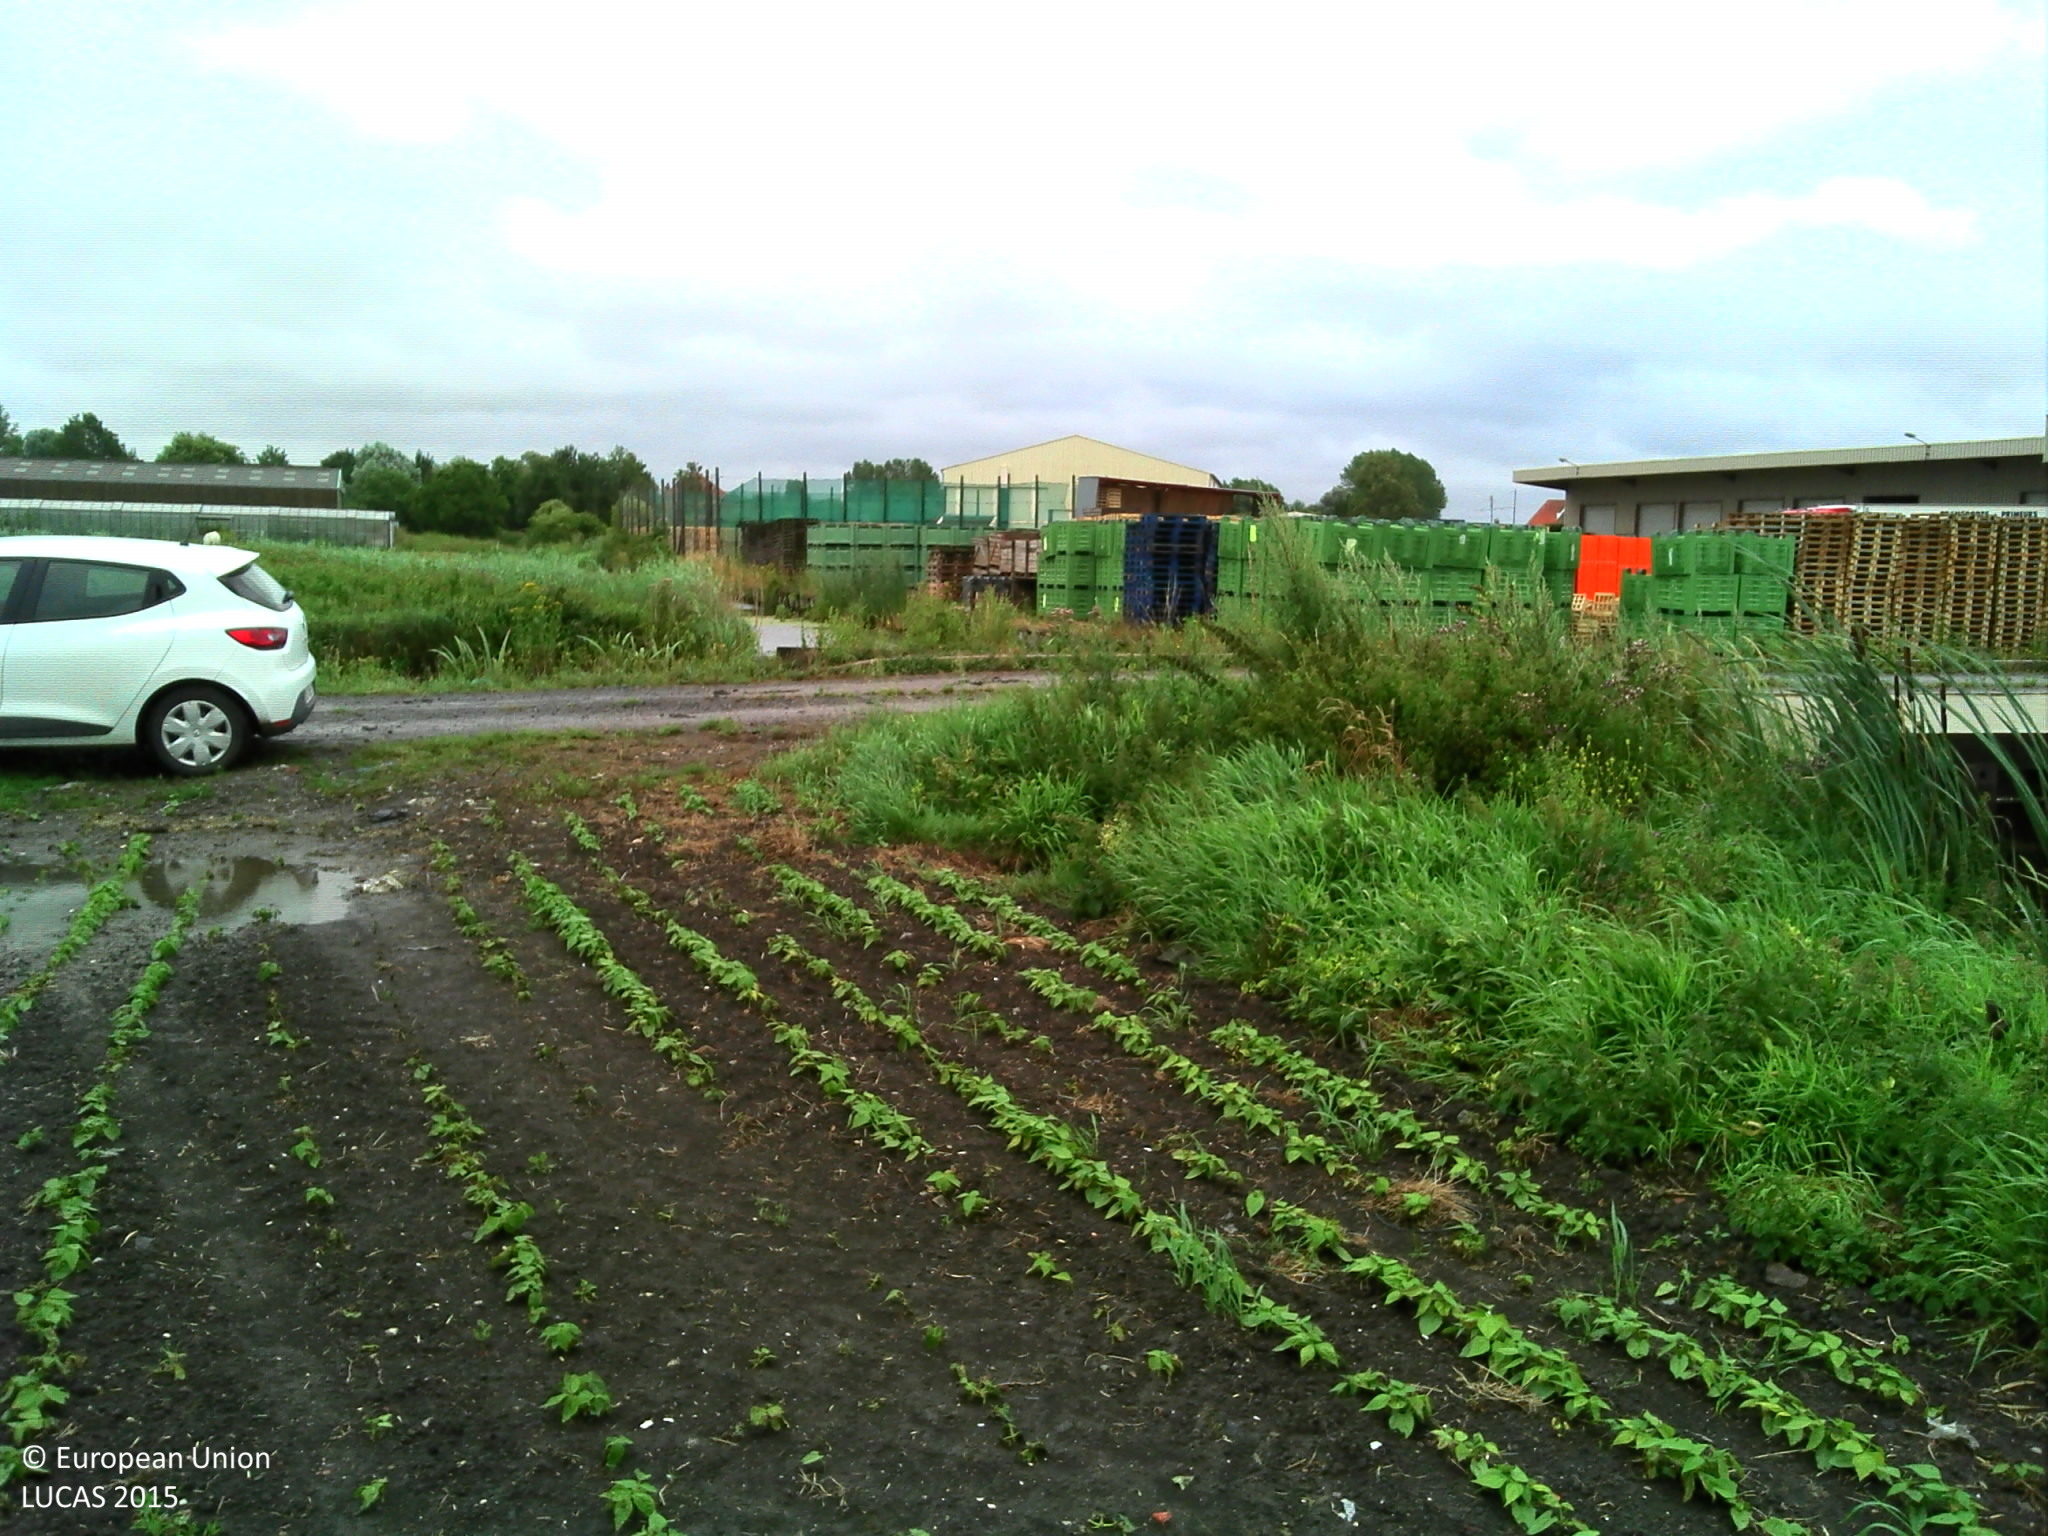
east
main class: Cropland
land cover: Other fresh vegetables
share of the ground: 25 - 50 %
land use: Agriculture (excluding fallow land and kitchen gardens)
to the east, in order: Other fresh vegetables; Grass margins; Paved roads, cycling and walking lanes; Spontaneously vegetated surfaces; Inland fresh running water; Artificial constructions in urban areas; Spontaneously vegetated surfaces
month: July
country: FR
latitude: 50.7698
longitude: 2.2580
